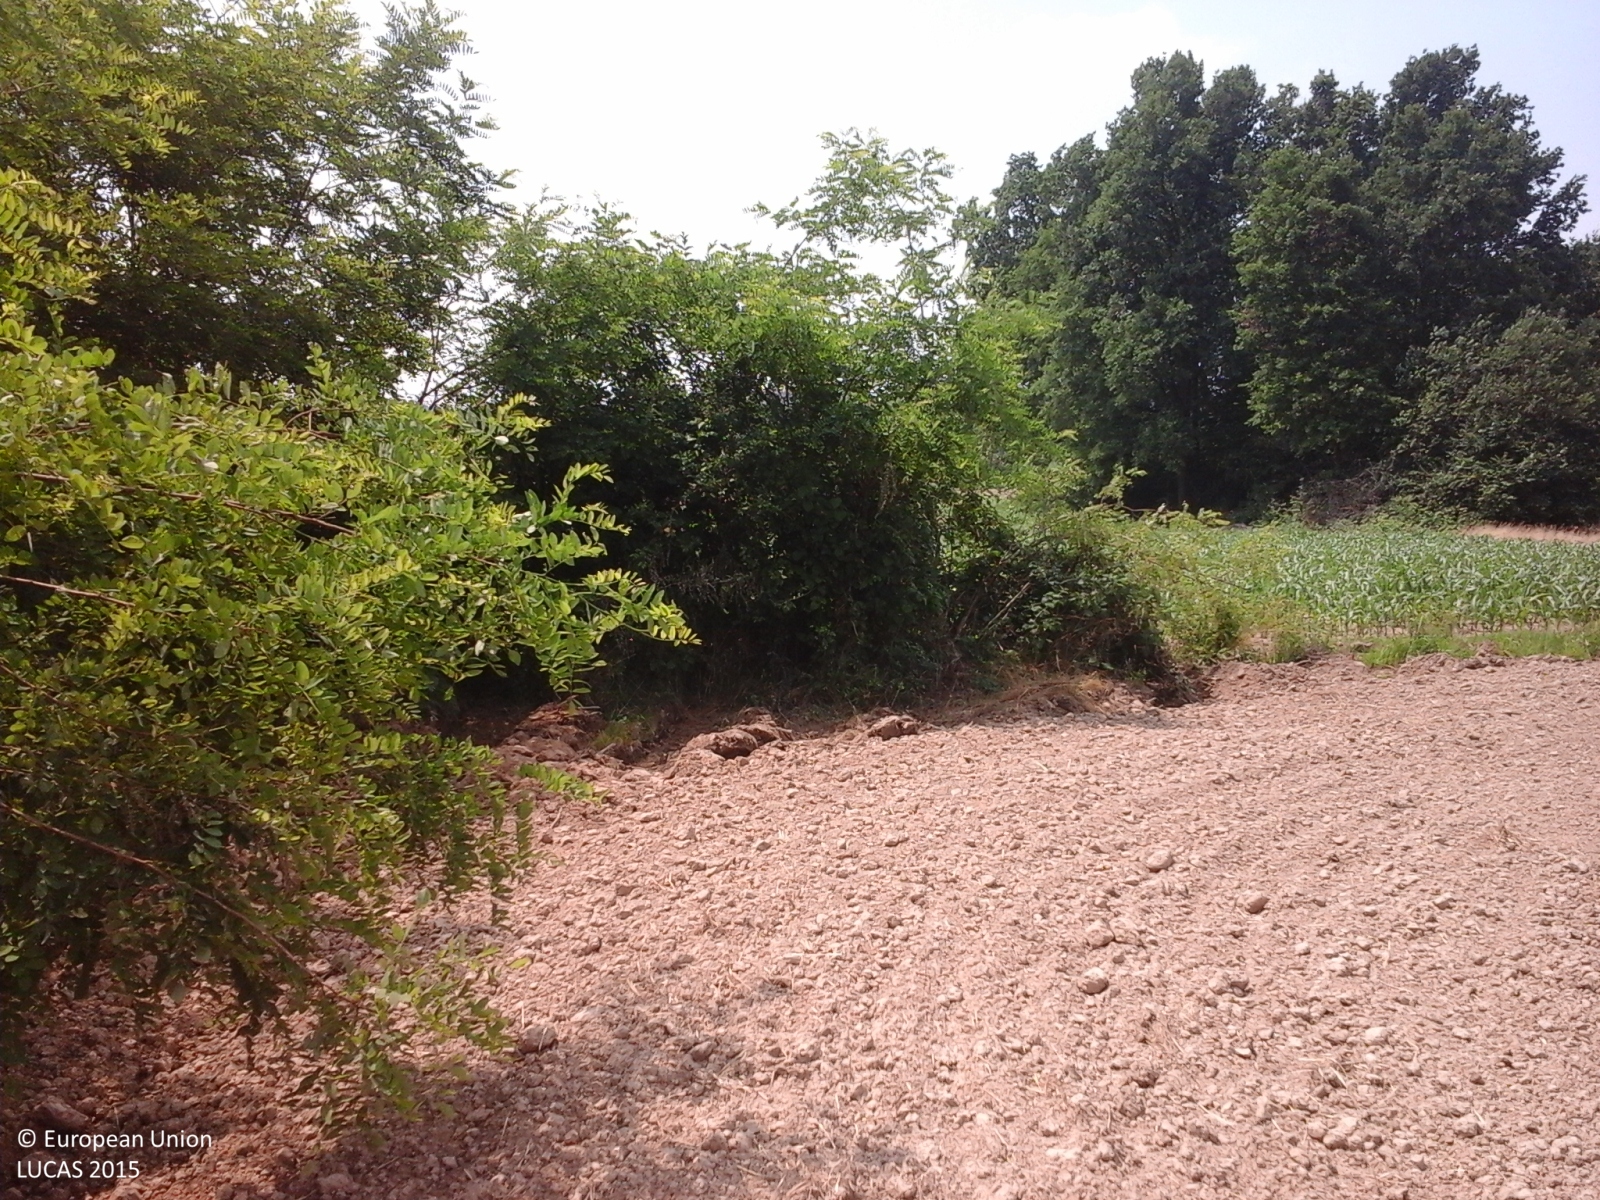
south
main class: Cropland
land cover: Soya
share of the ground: > 75 %
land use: Agriculture (excluding fallow land and kitchen gardens)
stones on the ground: < 10 %
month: May
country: IT
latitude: 45.2460
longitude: 7.7487
